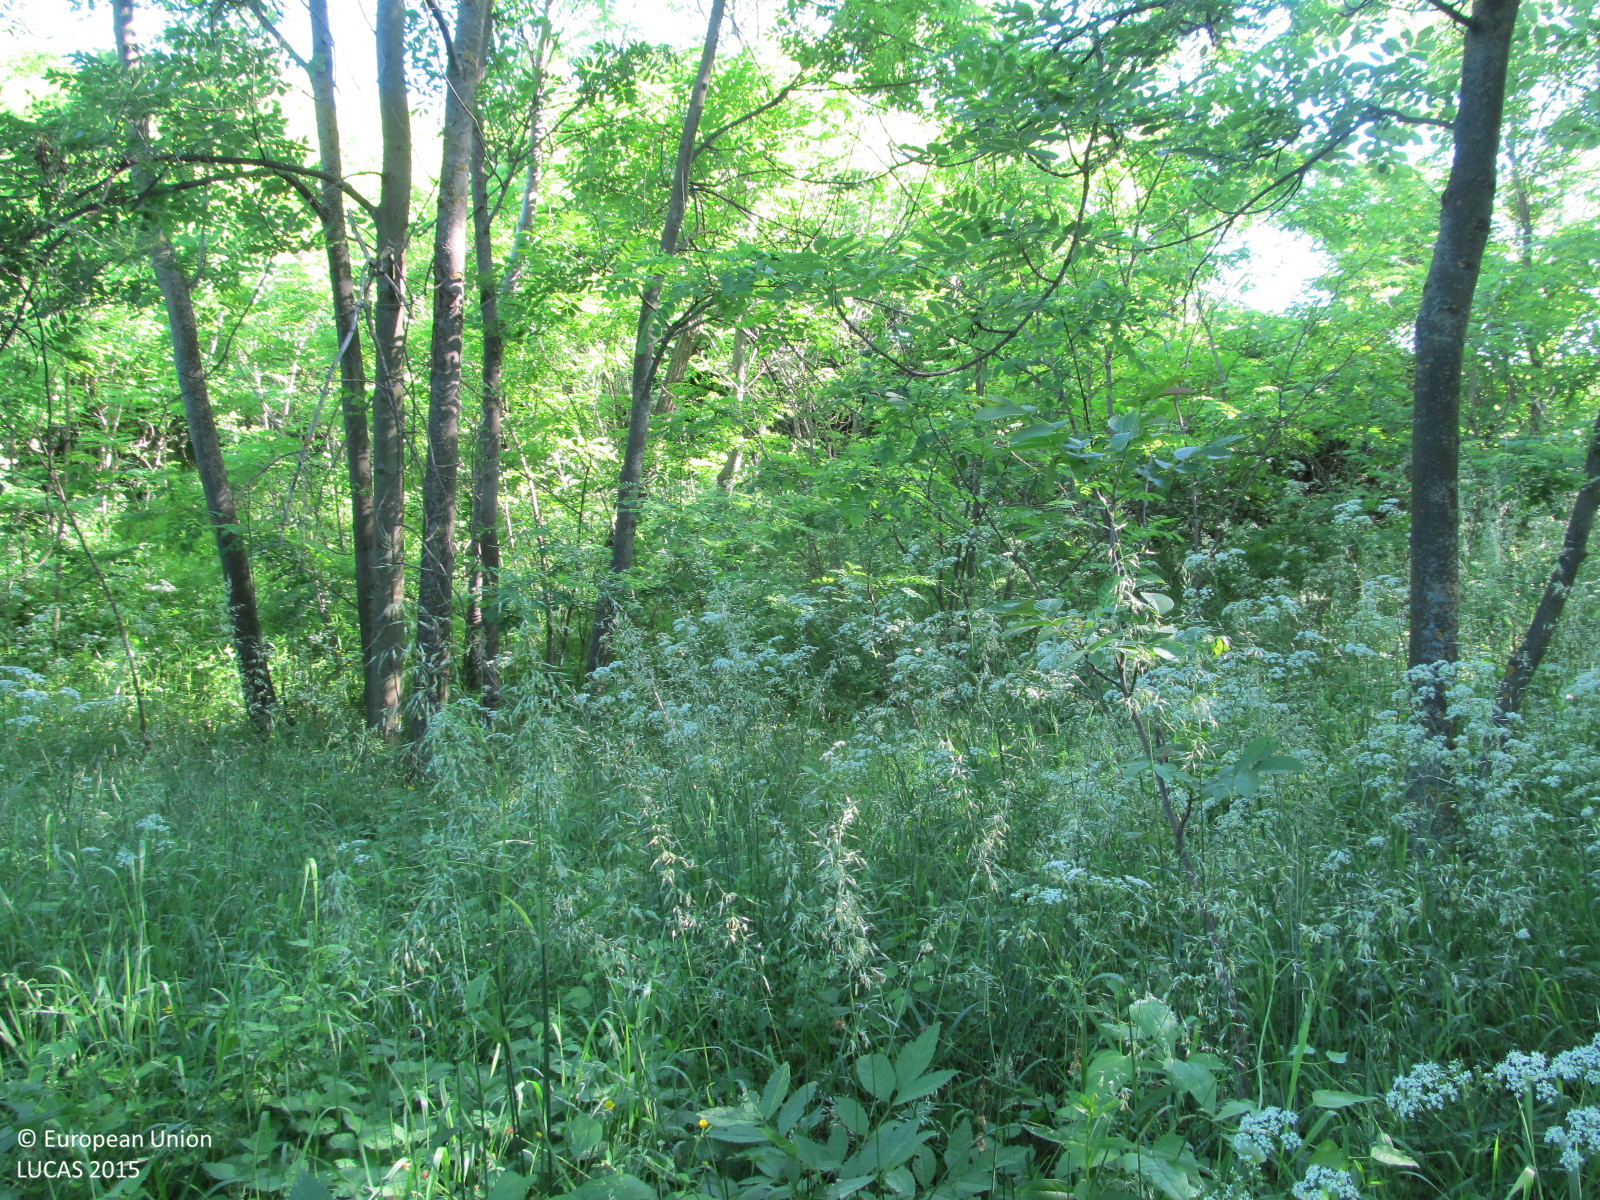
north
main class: Woodland
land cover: Broadleaved woodland
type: mesophytic deciduous forest
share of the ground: > 75 %
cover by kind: broadleaved forest trees 75 %, shrubs 15 %, herbaceous plants 10 %
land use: Semi-natural and natural areas not in use
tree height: > 5 m
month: June
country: AT
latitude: 48.4976
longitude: 15.9179
